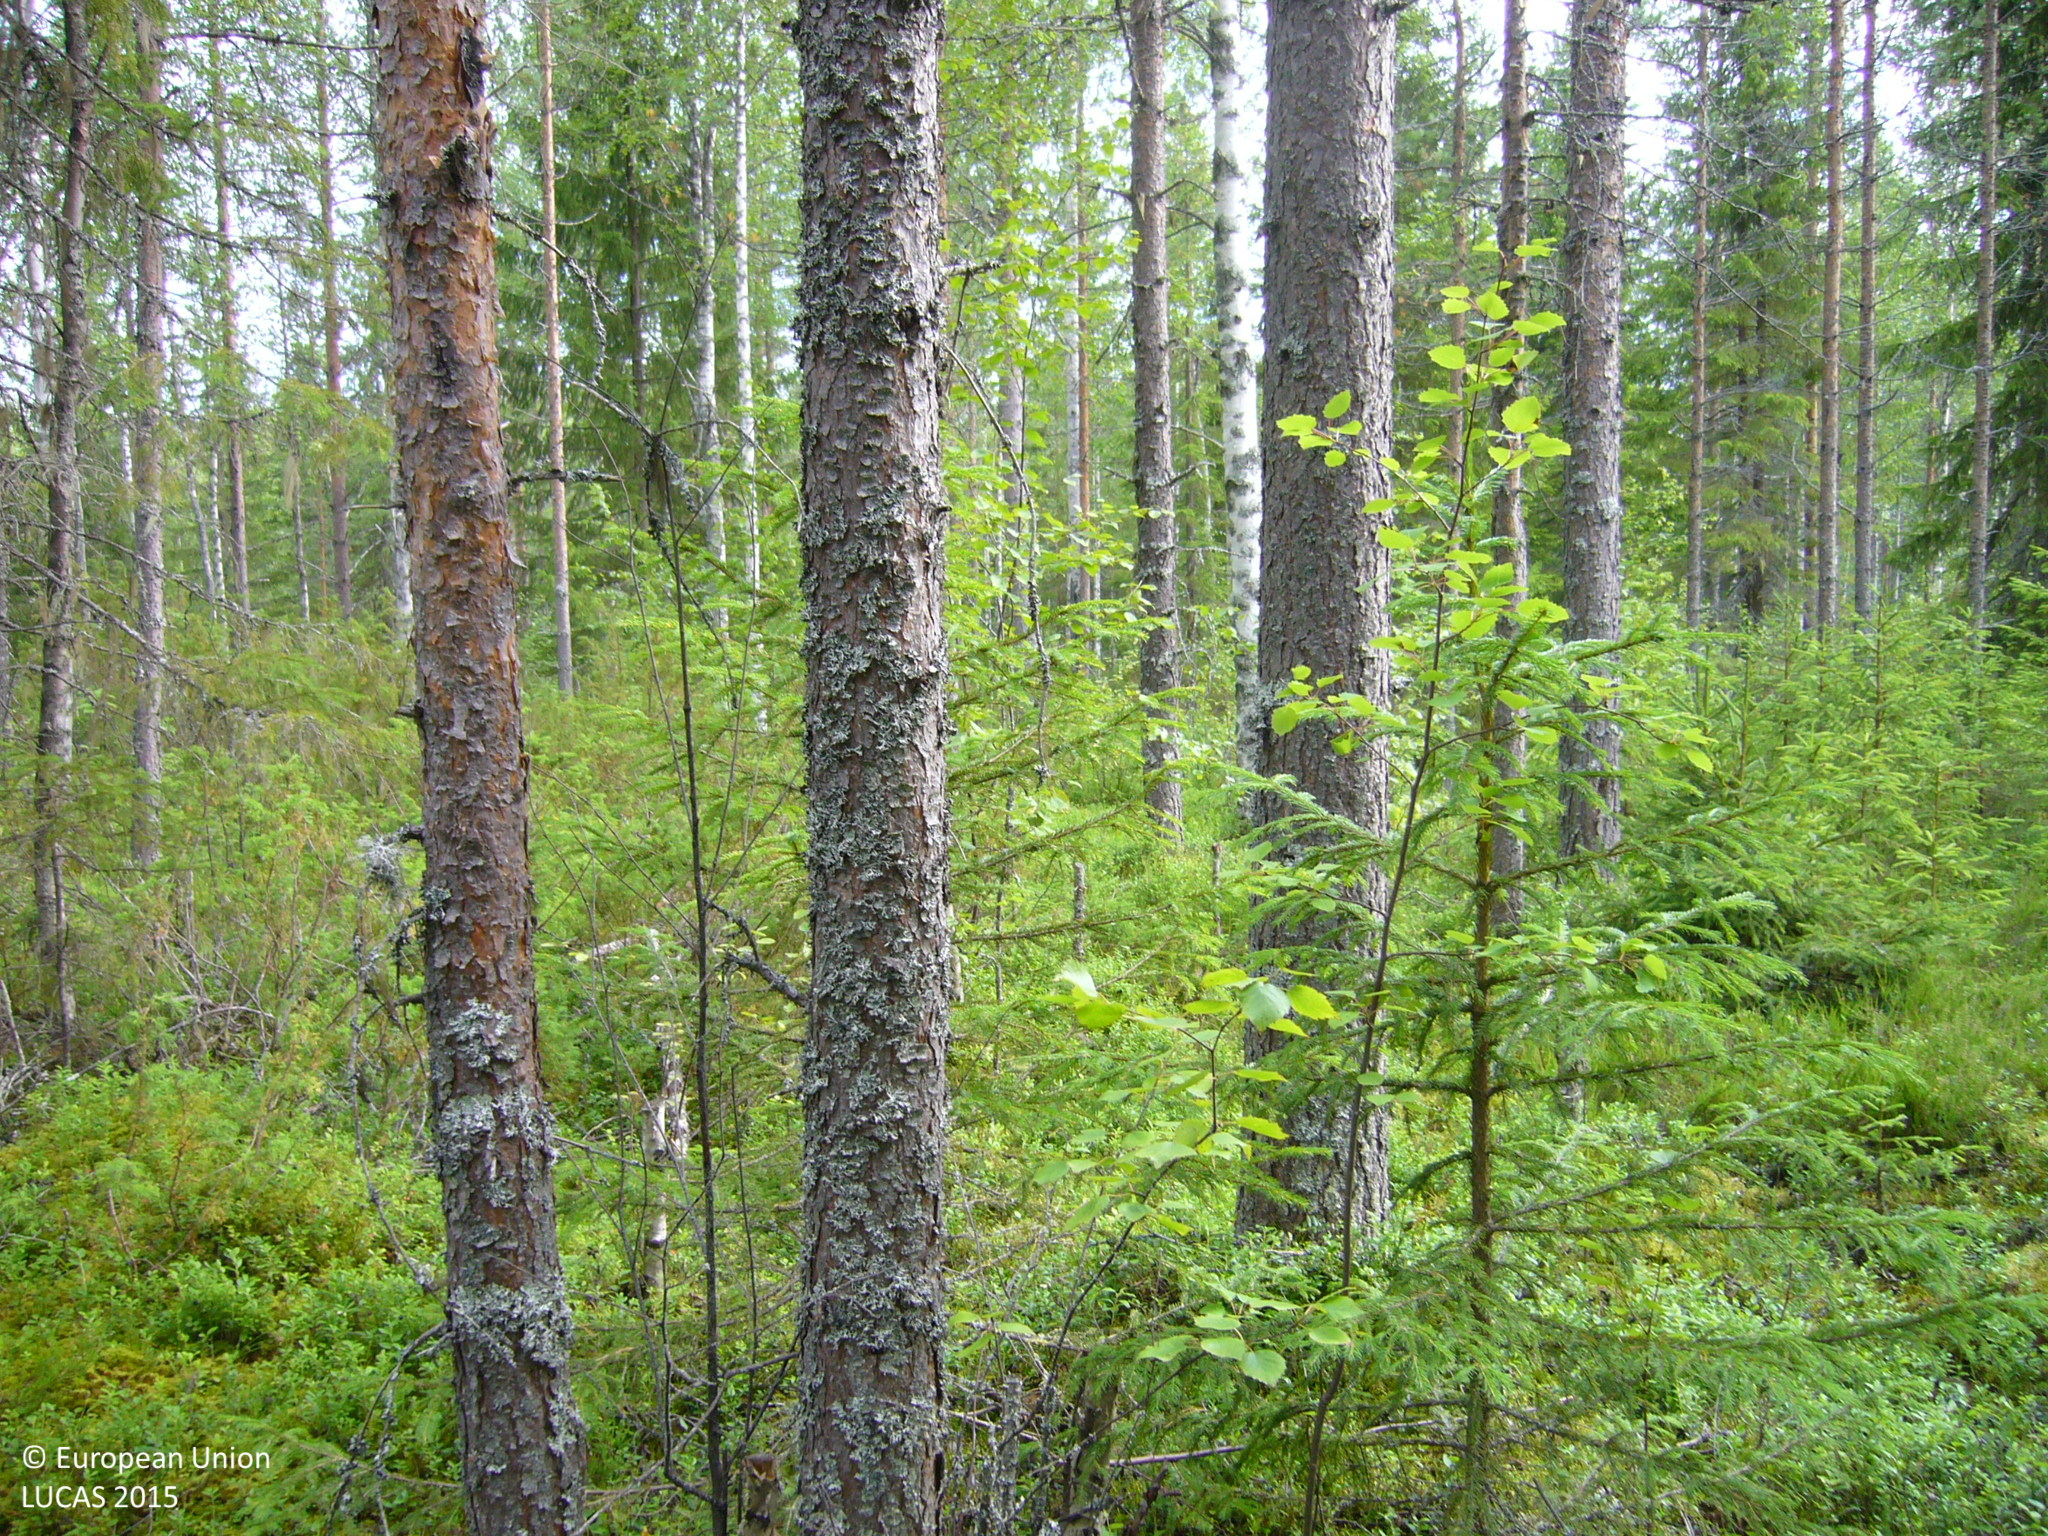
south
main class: Woodland
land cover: Pine dominated mixed woodland
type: boreal forest
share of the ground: > 75 %
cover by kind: coniferous forest trees 40 %, broadleaved forest trees 35 %, shrubs 25 %
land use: Forestry
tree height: > 5 m
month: July
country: FI
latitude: 63.9640
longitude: 26.7286
